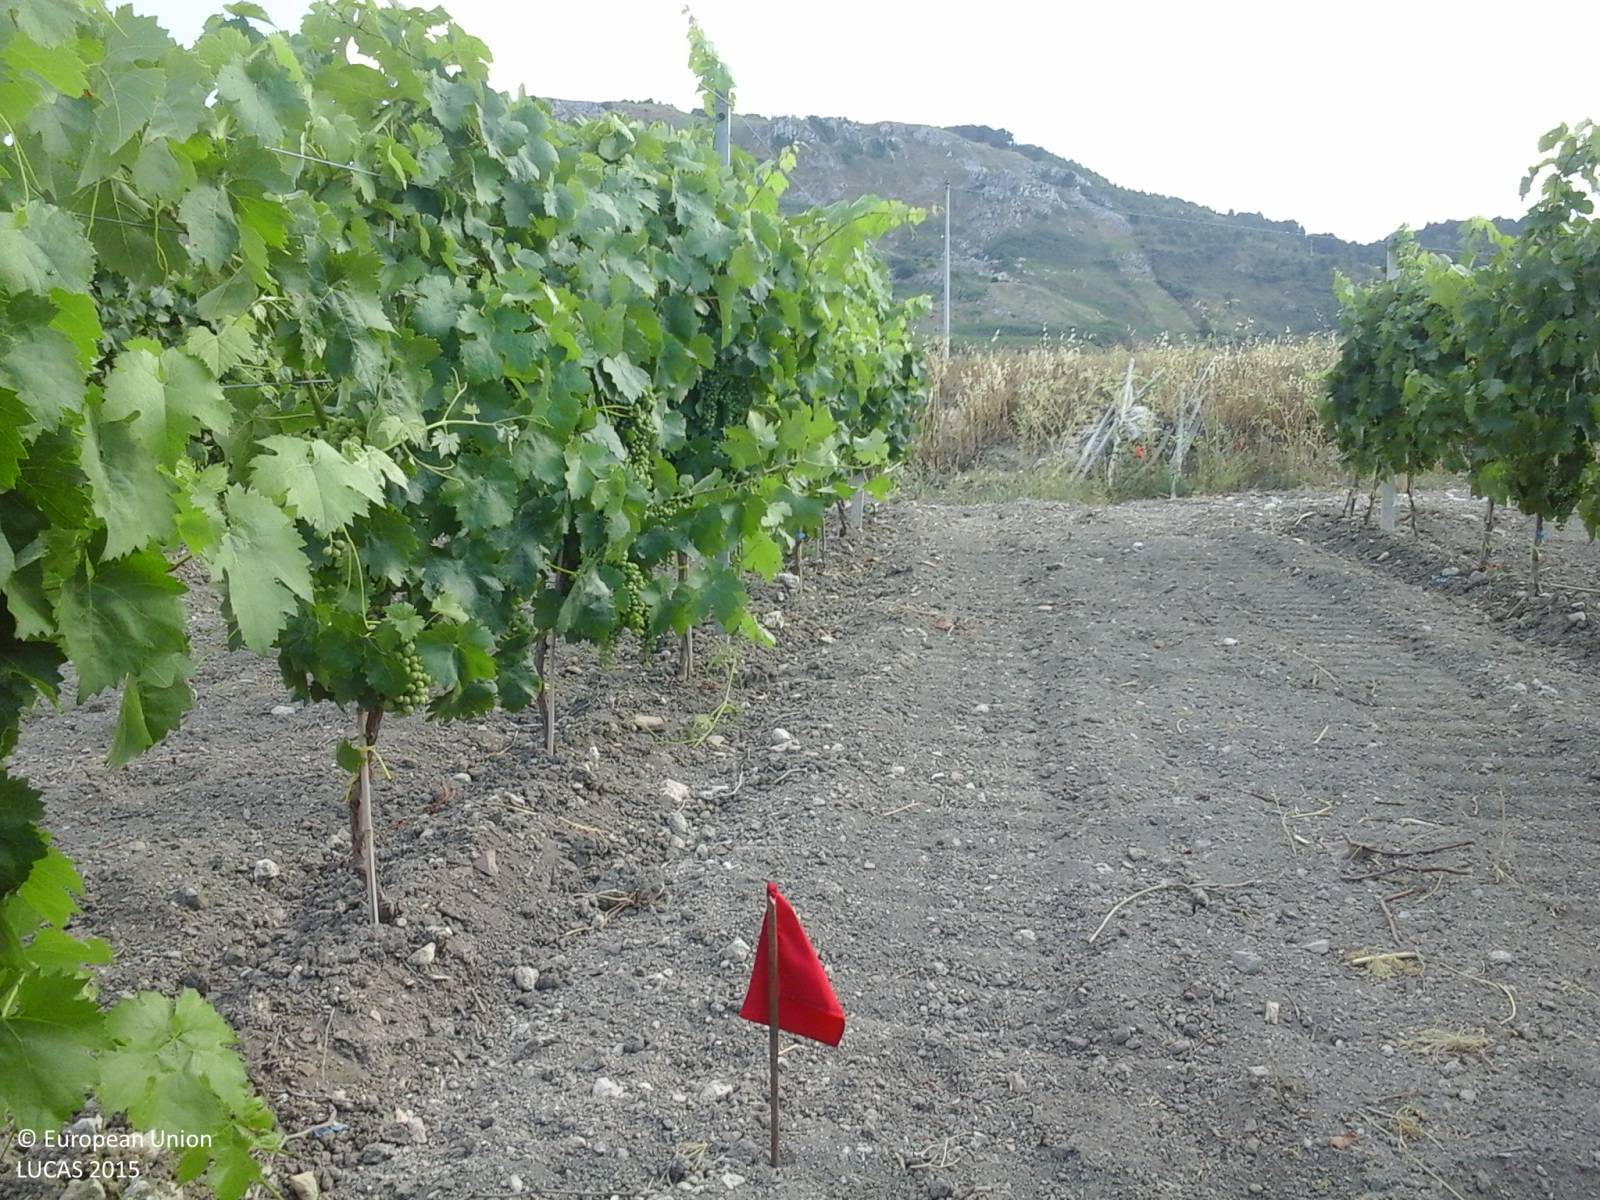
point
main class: Cropland
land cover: Vineyards
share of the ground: 10 - 25 %
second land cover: Other bare soil
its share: > 75 %
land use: Agriculture (excluding fallow land and kitchen gardens)
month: July
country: IT
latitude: 37.8117
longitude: 12.9204
